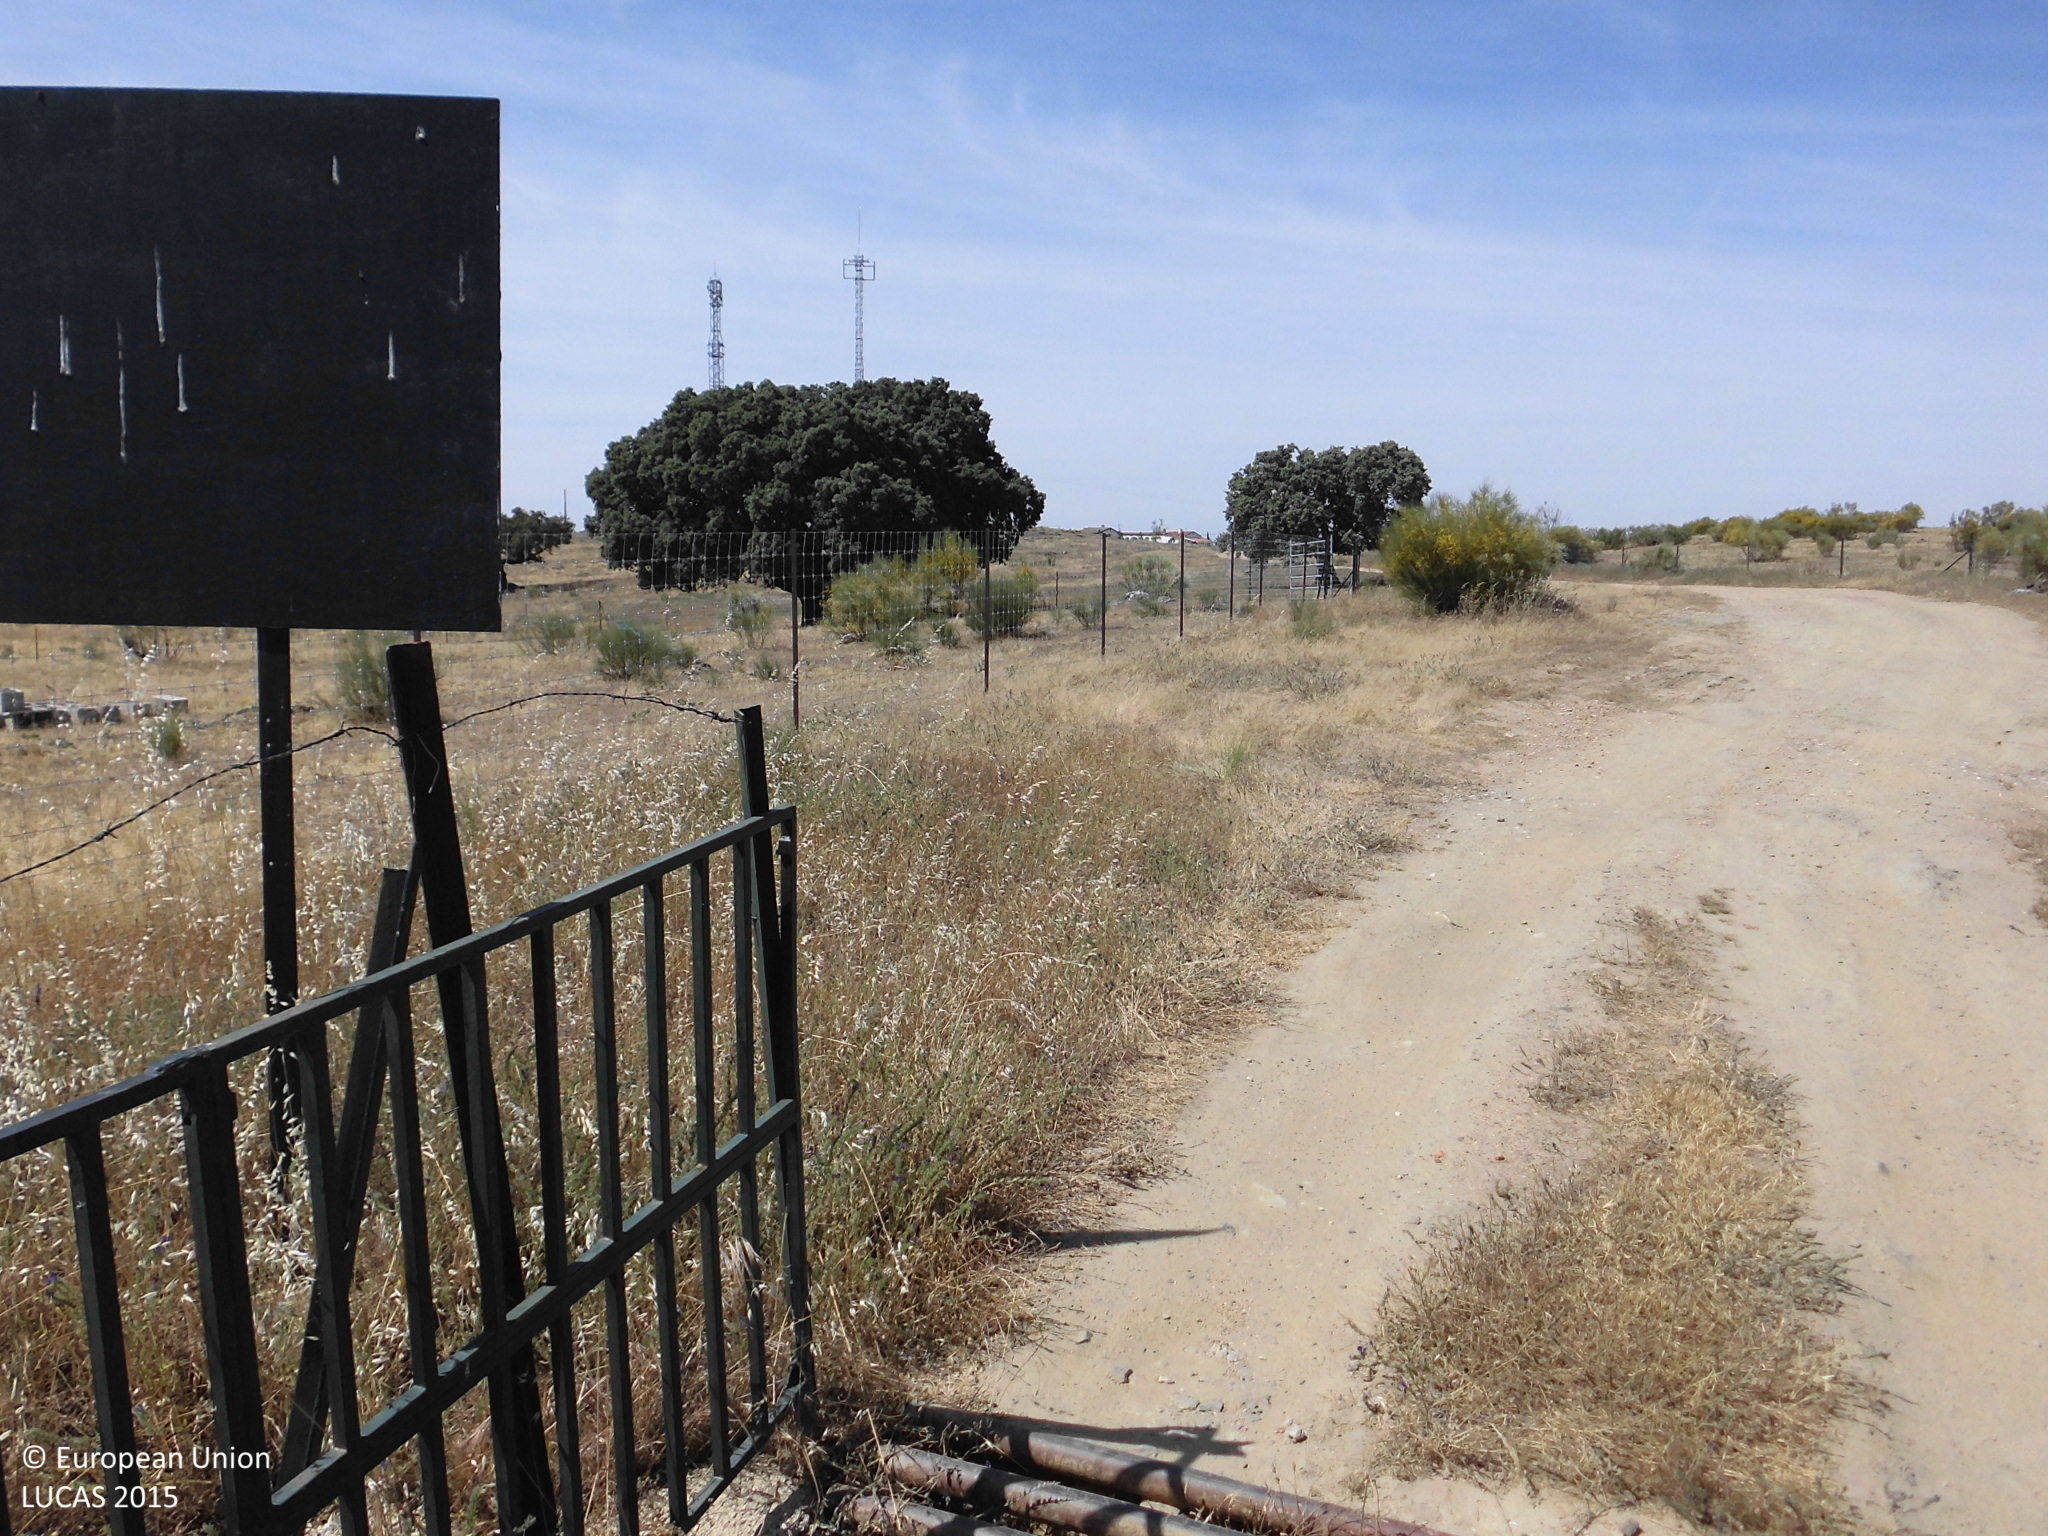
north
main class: Shrubland
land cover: Shrubland without tree cover
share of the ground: 10 - 25 %
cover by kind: herbaceous plants 85 %, shrubs 15 %
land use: Agriculture (excluding fallow land and kitchen gardens)
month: May
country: ES
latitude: 39.4456
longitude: -6.0856
